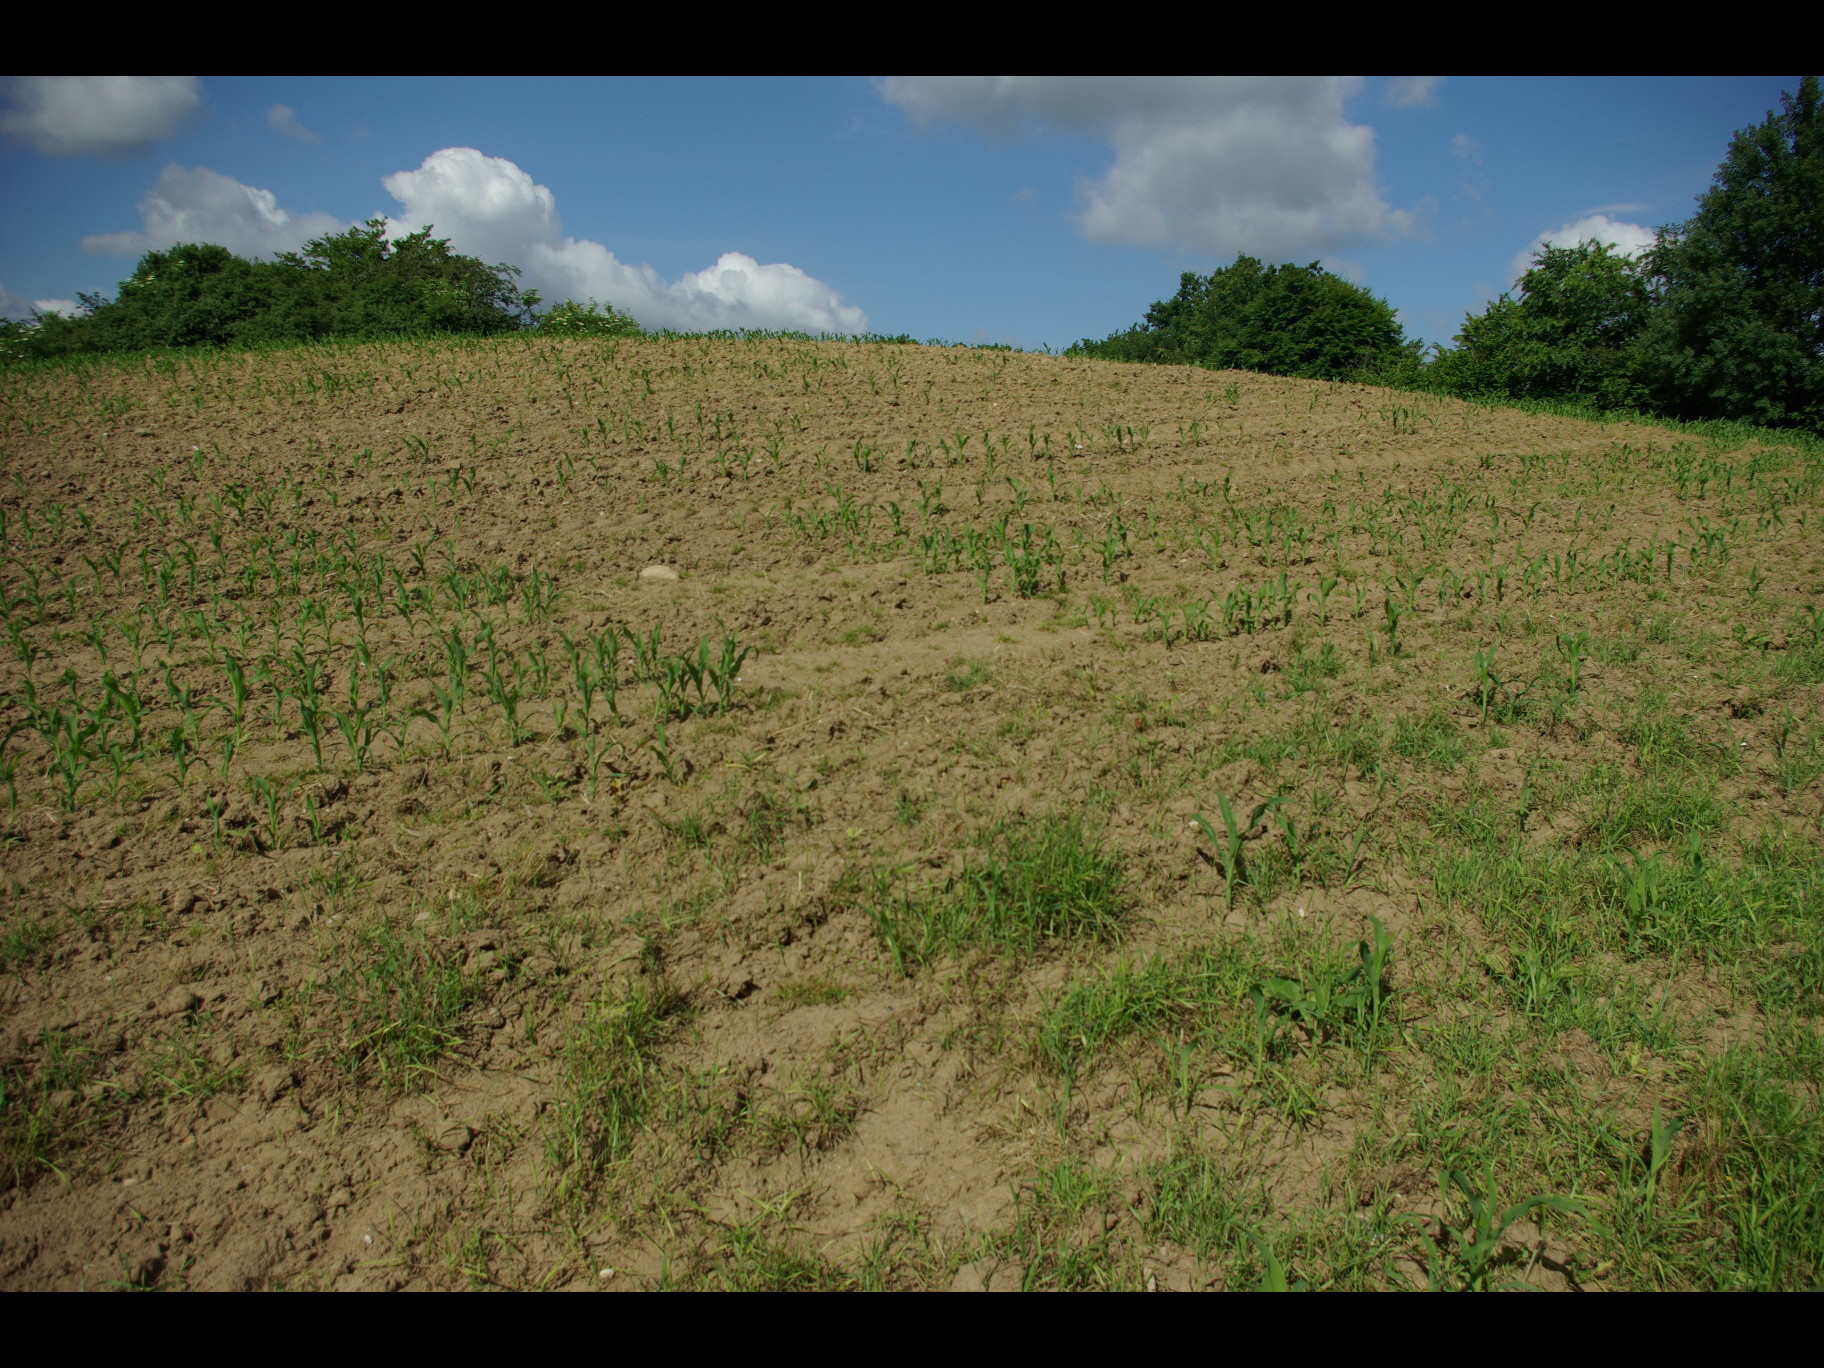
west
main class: Cropland
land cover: Maize
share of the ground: 10 - 25 %
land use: Agriculture (excluding fallow land and kitchen gardens)
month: June
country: DE
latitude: 54.2466
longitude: 9.8926
